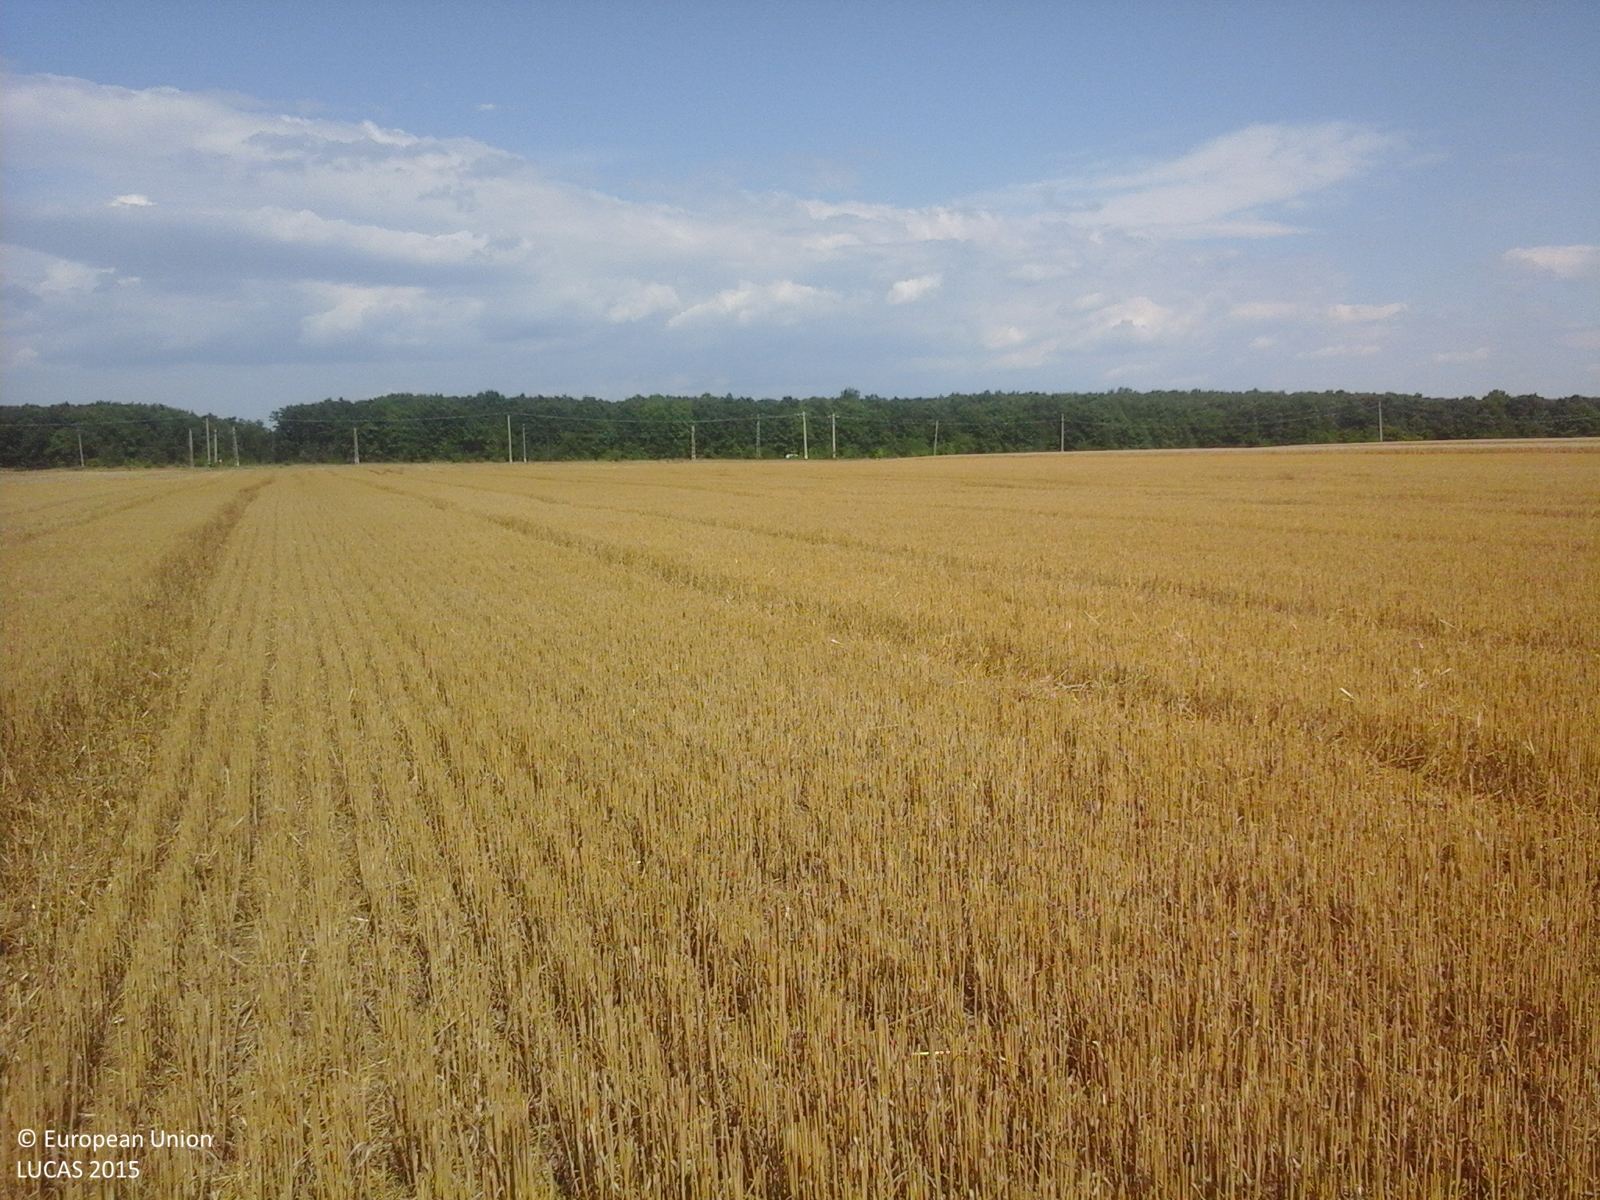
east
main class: Cropland
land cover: Common wheat
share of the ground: < 10 %
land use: Agriculture (excluding fallow land and kitchen gardens)
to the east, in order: Common wheat
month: July
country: RO
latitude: 44.3508
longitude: 25.3801
